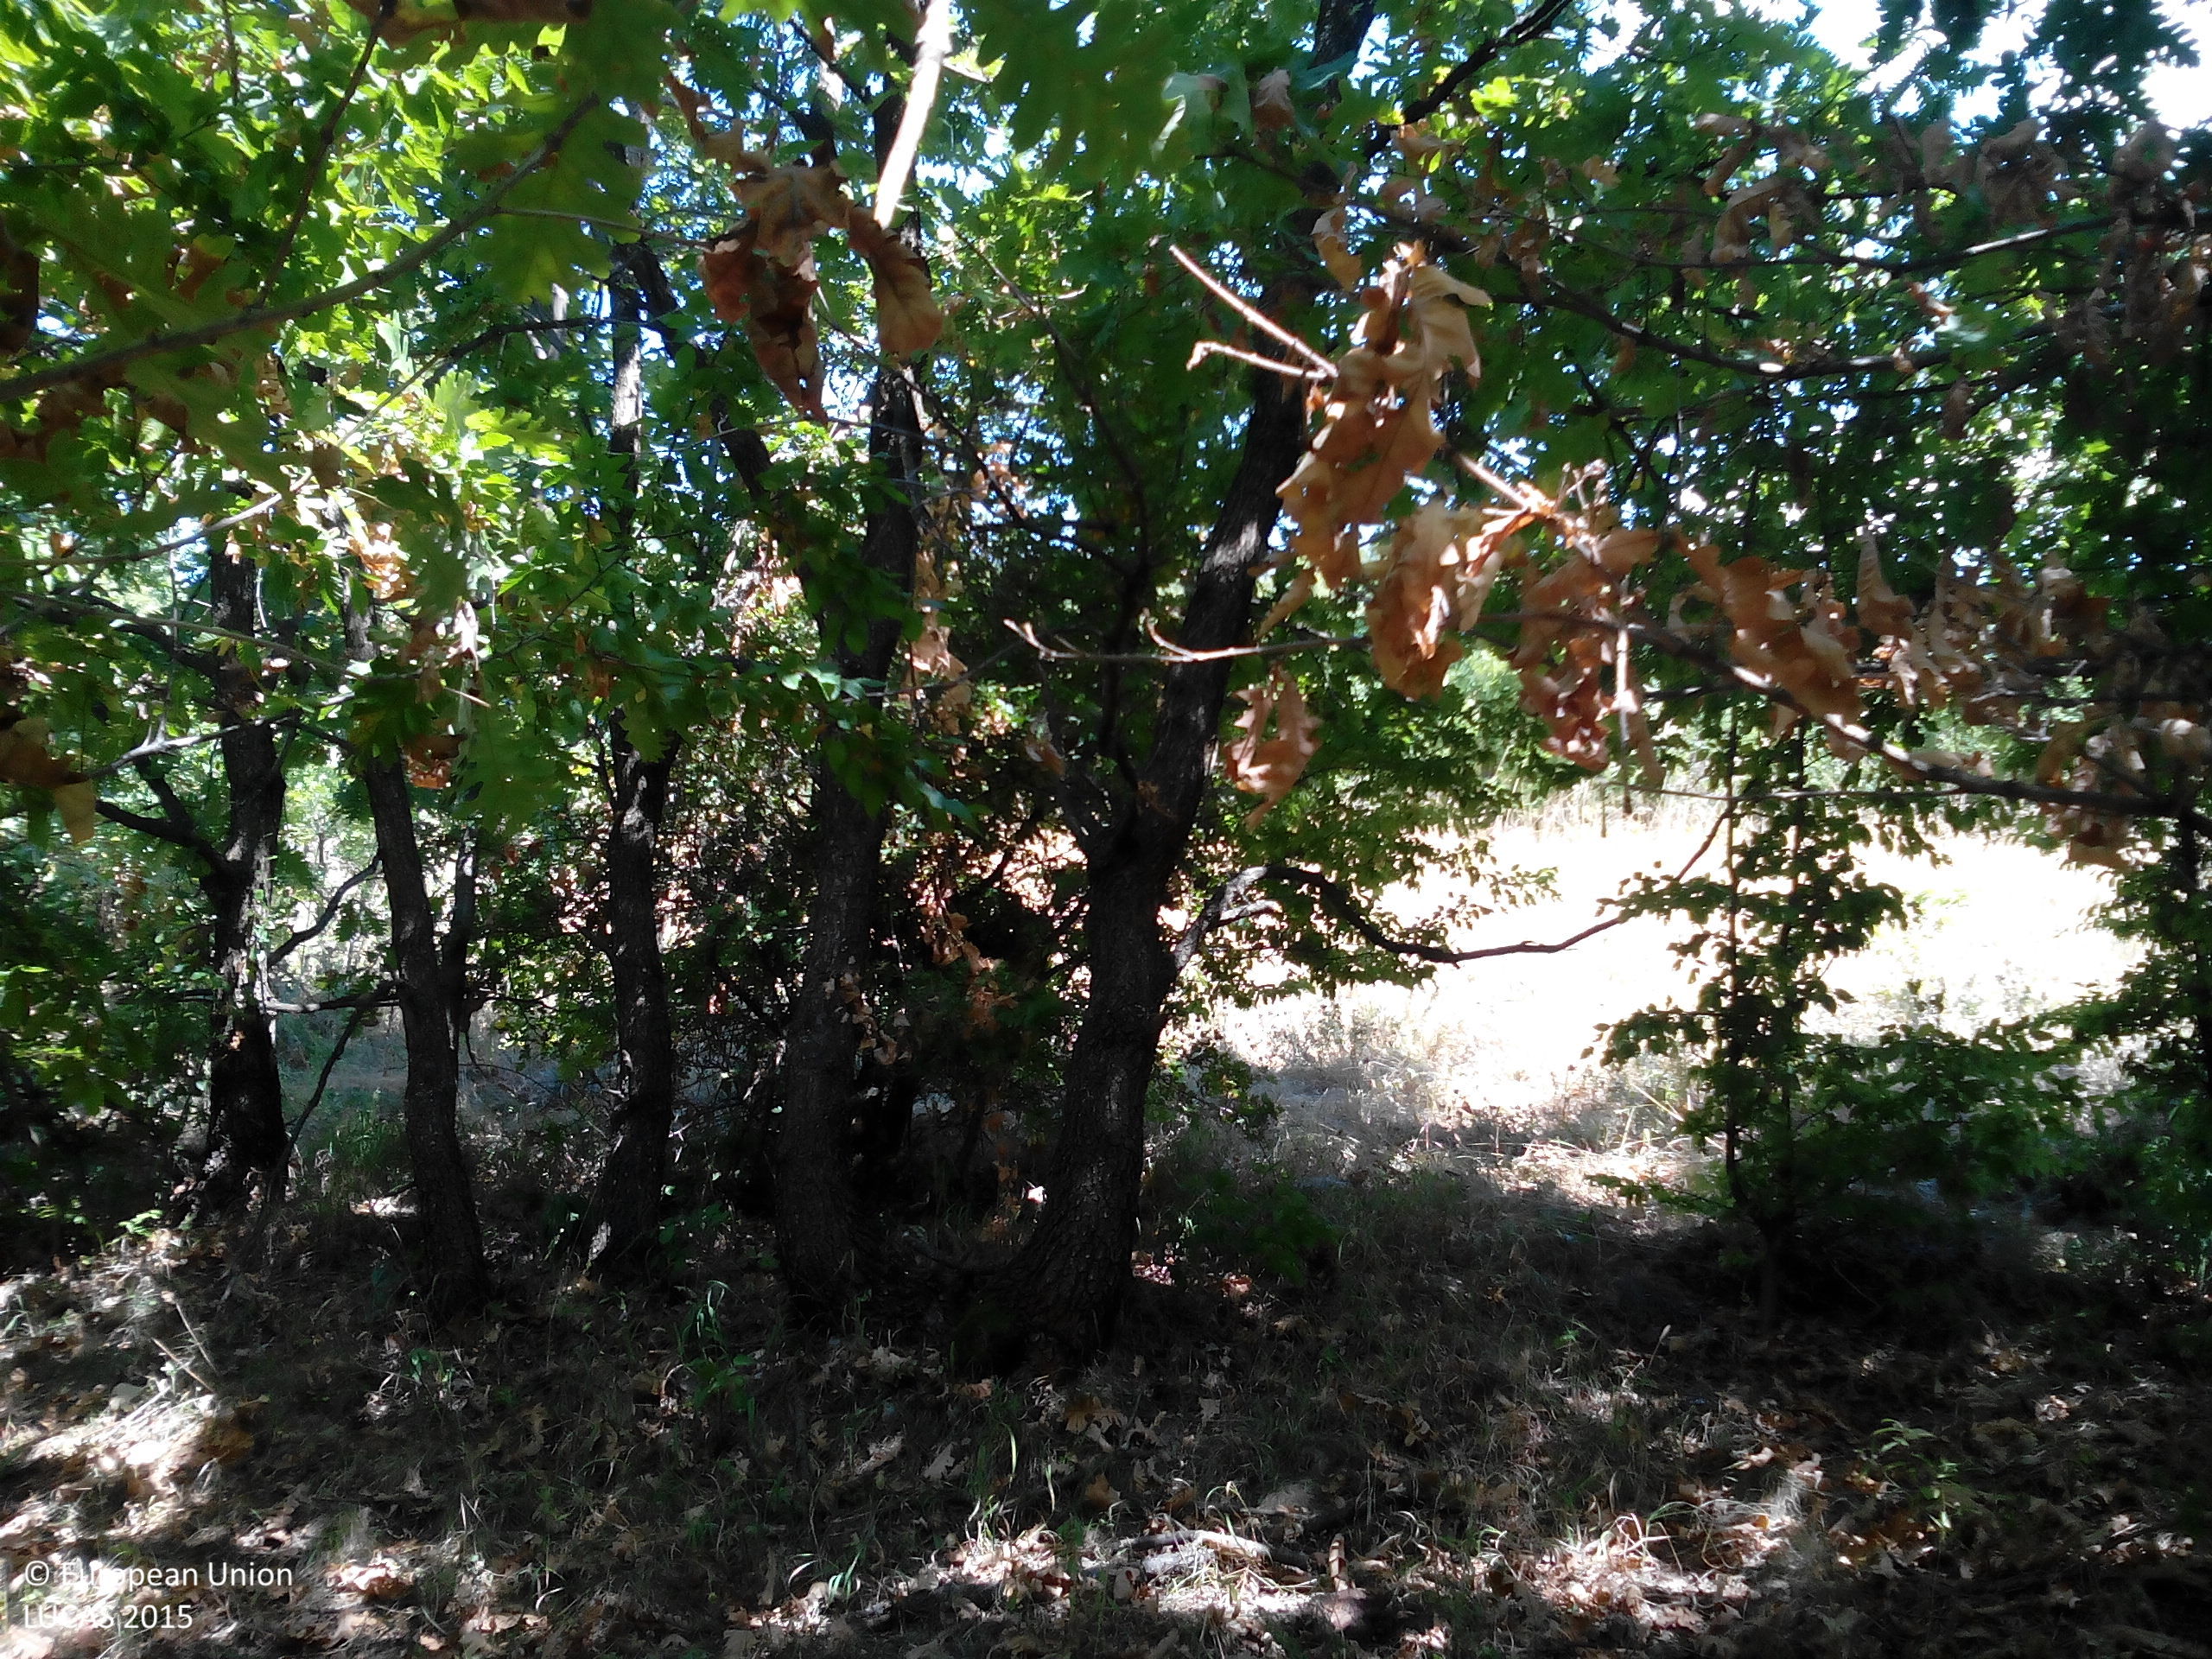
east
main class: Woodland
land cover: Broadleaved woodland
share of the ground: > 75 %
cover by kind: broadleaved forest trees 90 %, shrubs 5 %, herbaceous plants 5 %
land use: Forestry
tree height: > 5 m
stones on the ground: 10 - 25 %
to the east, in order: Broadleaved woodland; Tracks; Broadleaved woodland; Tracks; Broadleaved woodland; Tracks; Grassland with sparse tree/shrub cover
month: August
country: BG
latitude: 43.2311
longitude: 23.6002
